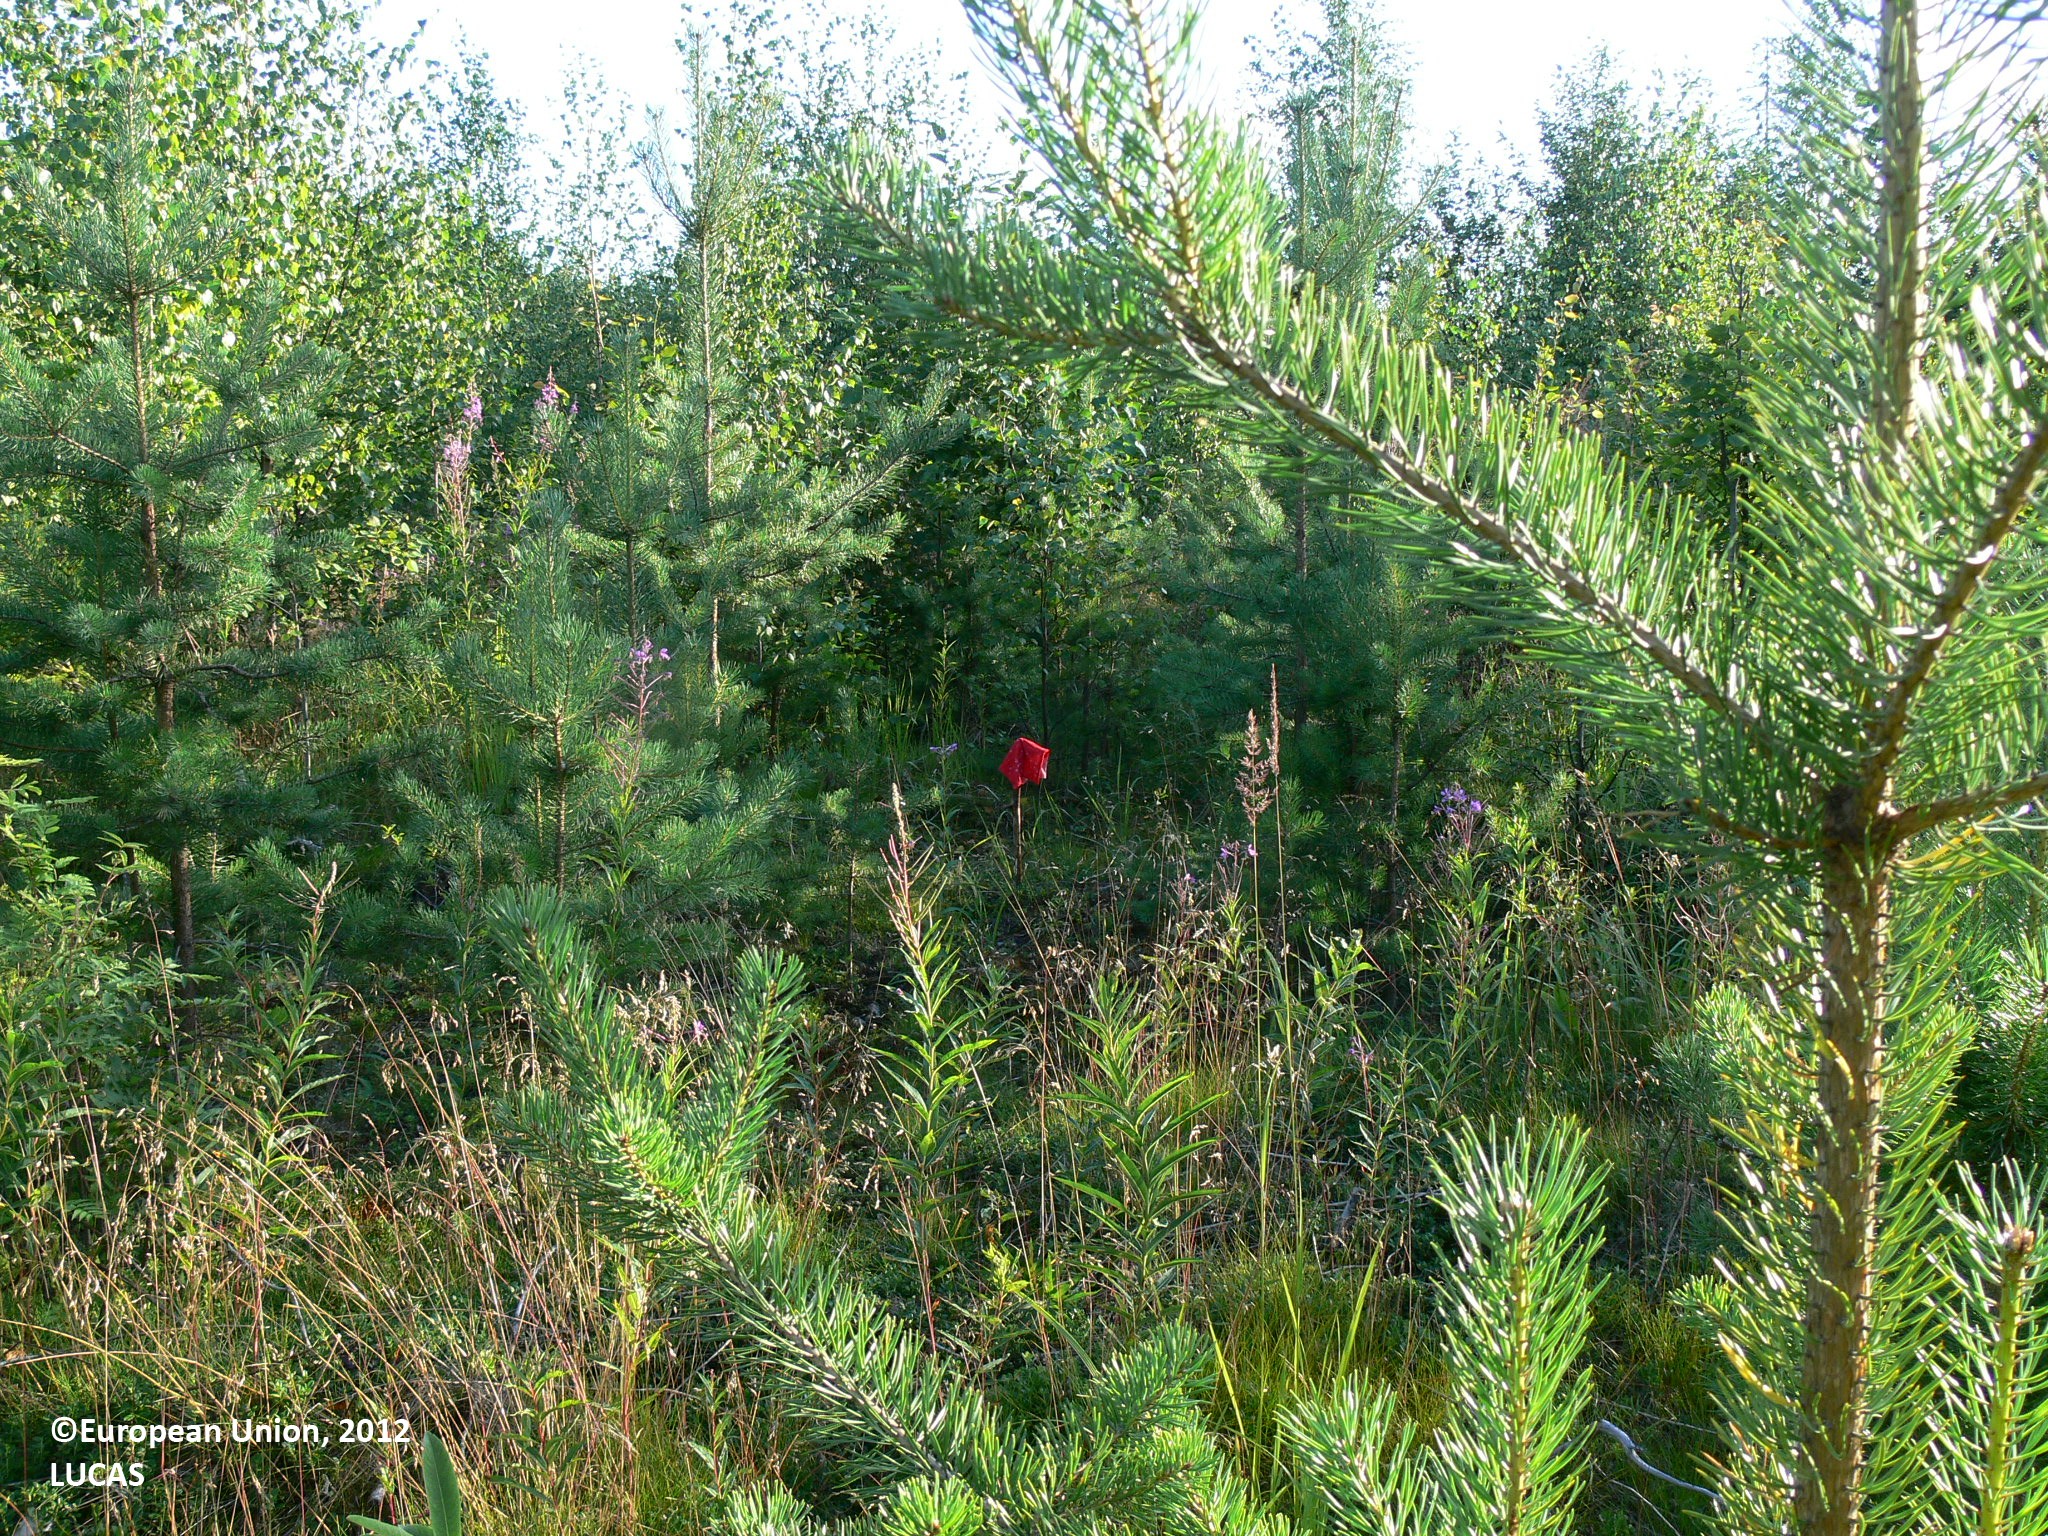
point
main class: Woodland
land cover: Pine dominated mixed woodland
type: boreal forest
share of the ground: 25 - 50 %
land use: Forestry
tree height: < 5 m
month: August
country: FI
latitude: 61.9582
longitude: 29.1665
